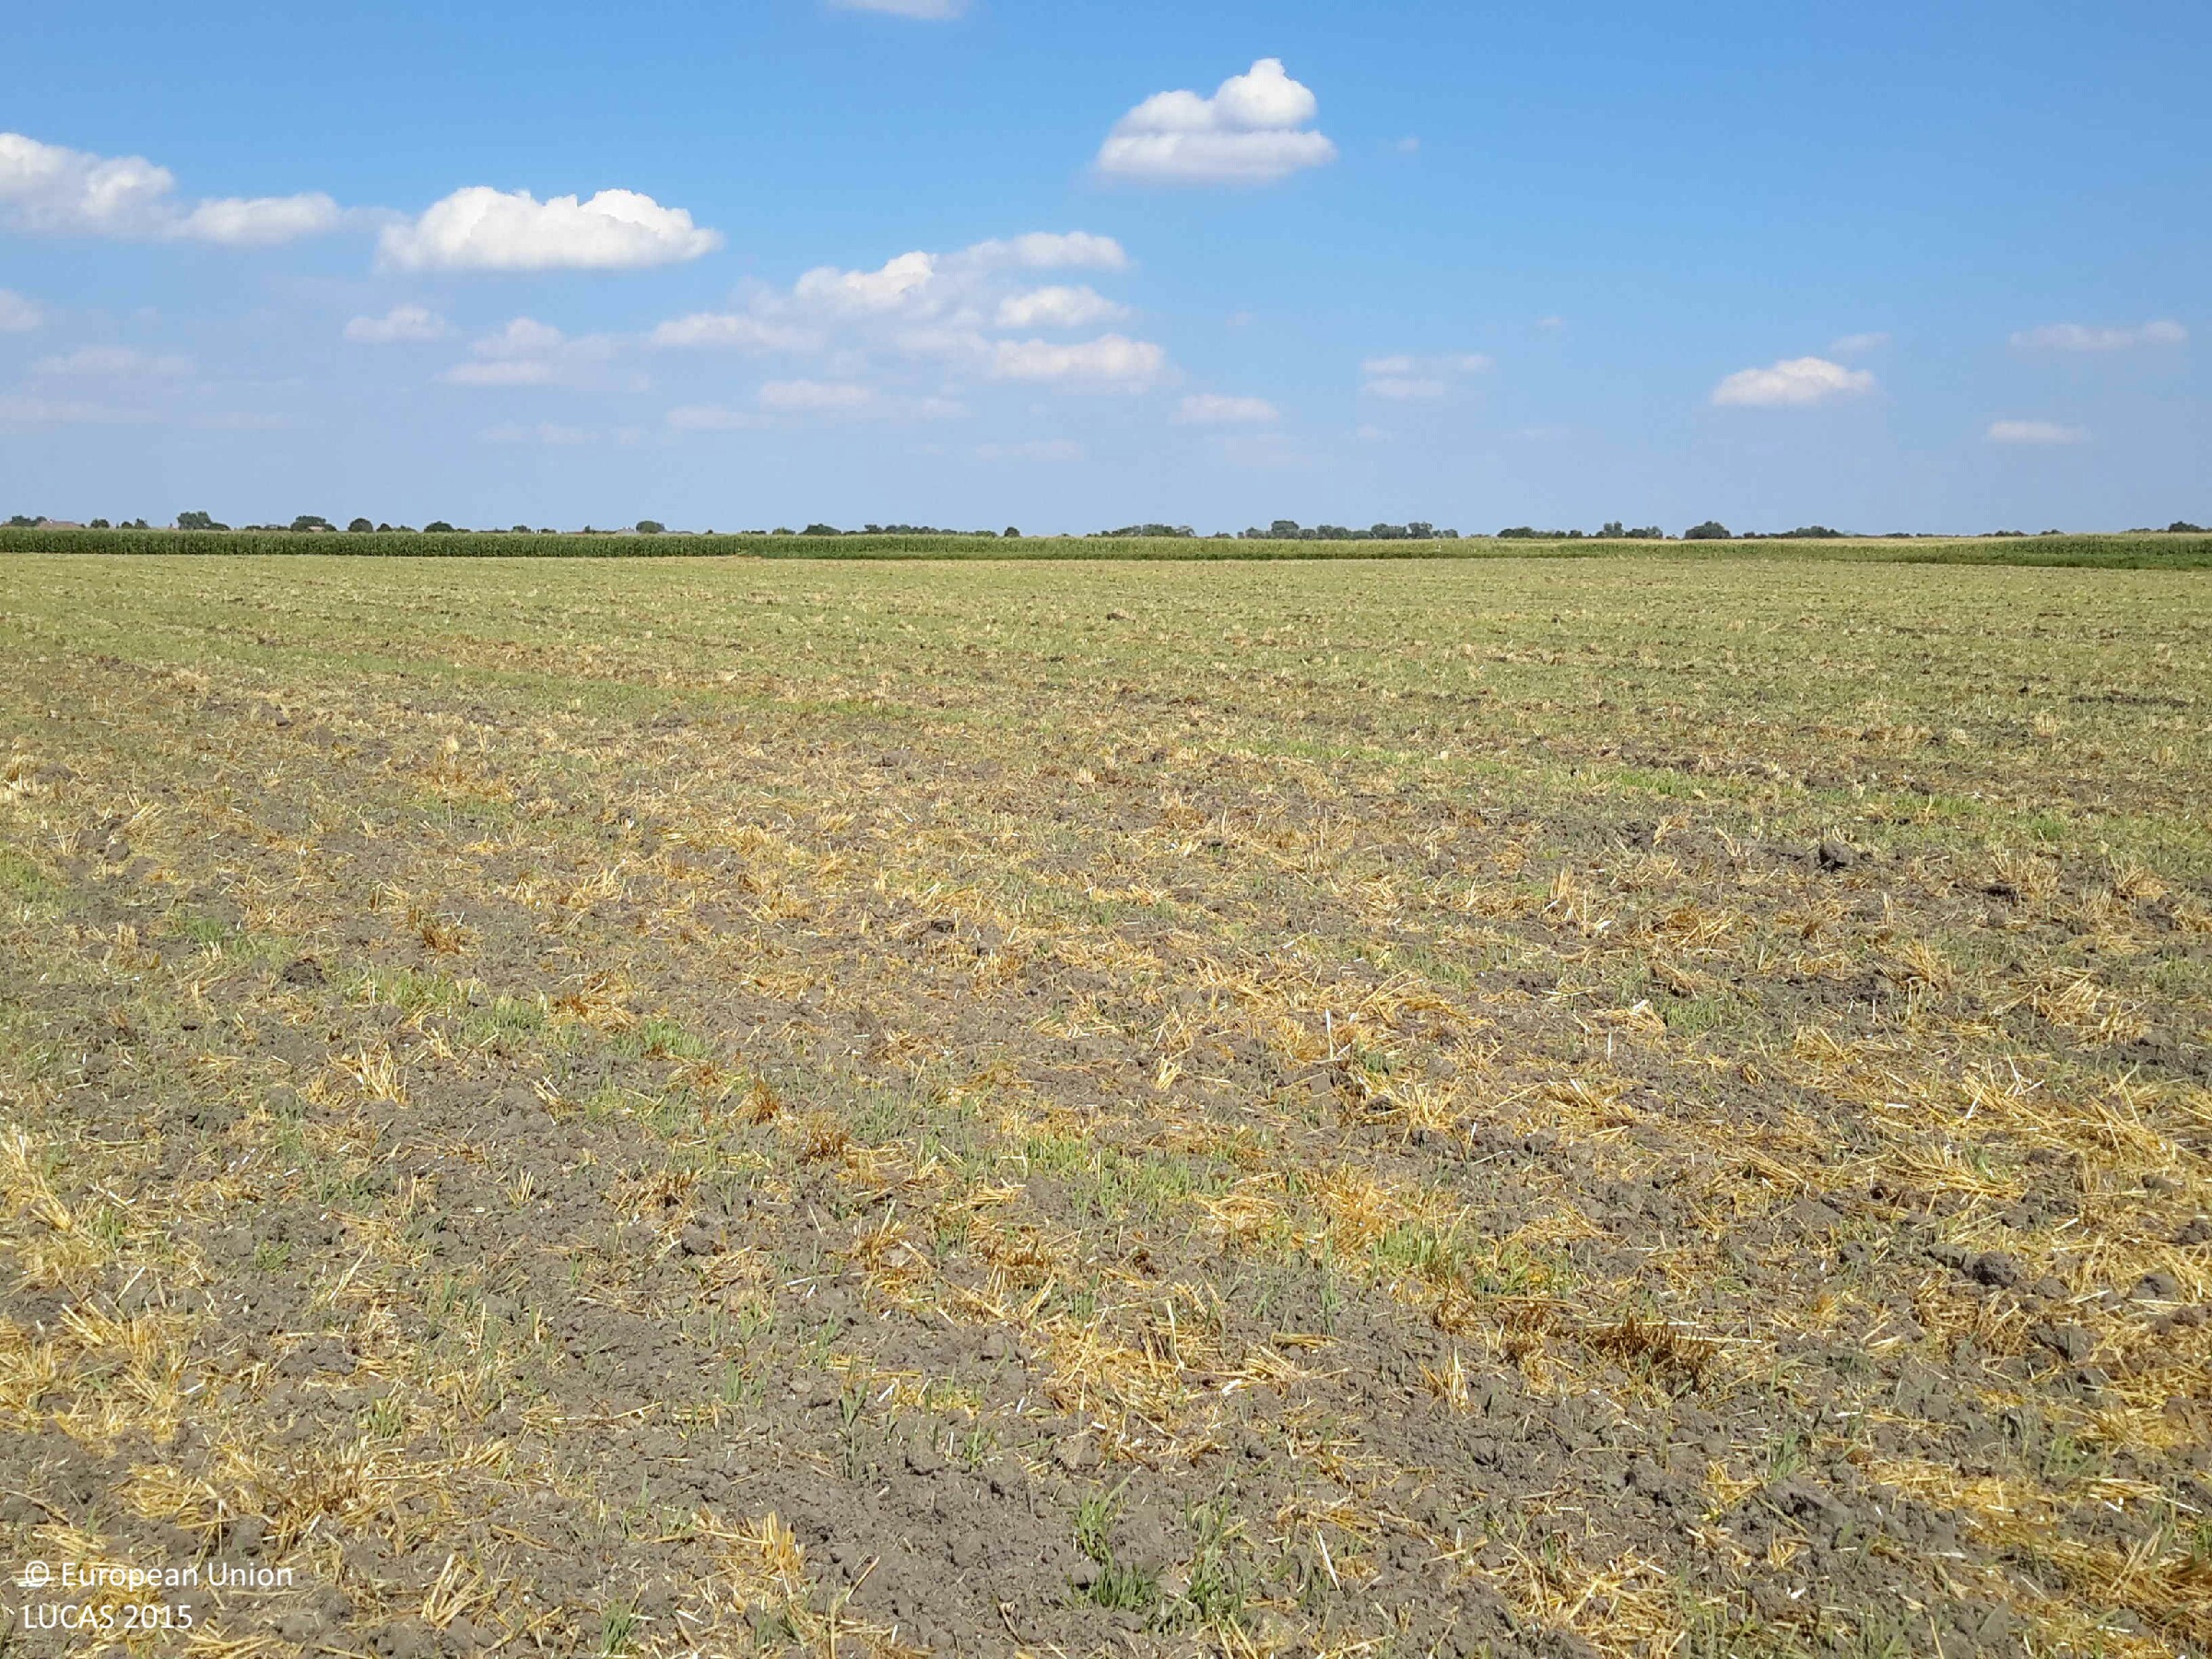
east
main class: Cropland
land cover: Common wheat
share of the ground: < 10 %
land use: Agriculture (excluding fallow land and kitchen gardens)
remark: Harvested field
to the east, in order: Common wheat; Soya
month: July
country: HU
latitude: 47.5626
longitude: 17.8651
